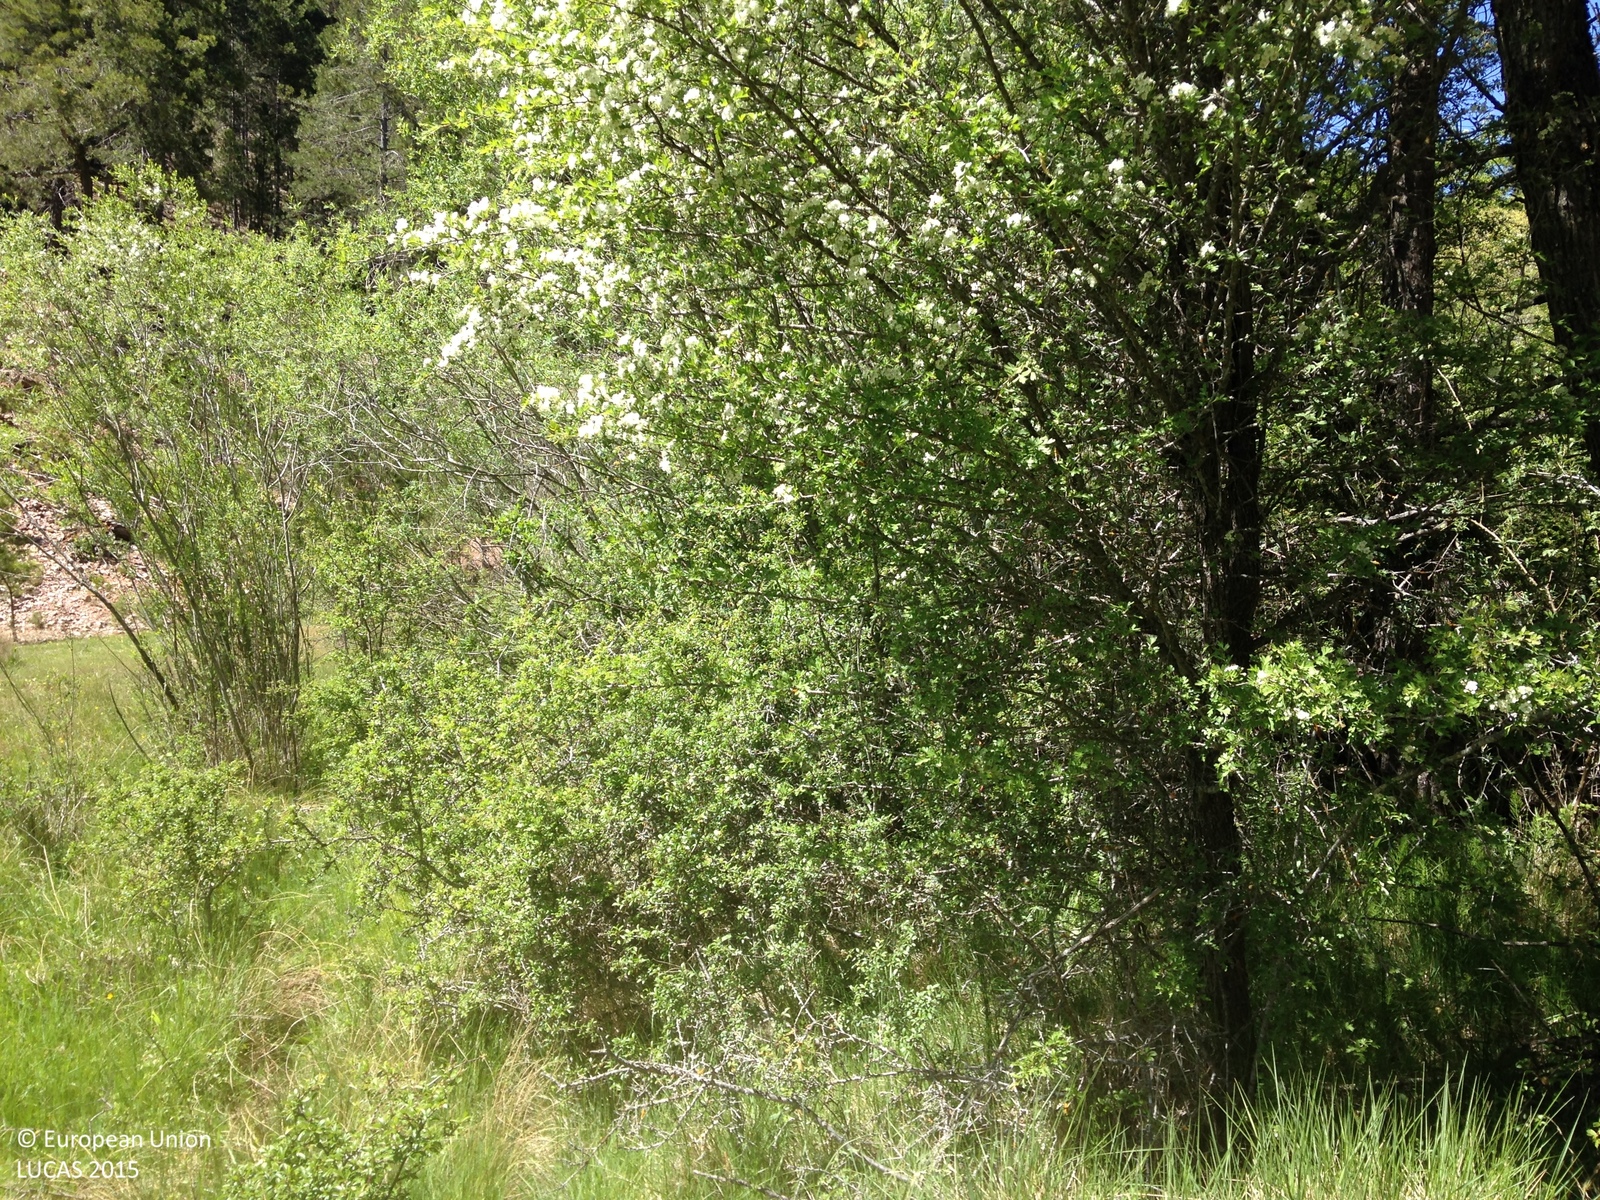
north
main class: Woodland
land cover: Pine dominated coniferous woodland
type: coniferous forest of the mediterranean region
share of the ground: > 75 %
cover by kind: coniferous forest trees 50 %, shrubs 20 %, herbaceous plants 20 %, consolidated bare surface 10 %
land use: Semi-natural and natural areas not in use
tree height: > 5 m
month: May
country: ES
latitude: 40.5680
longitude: -2.0092
